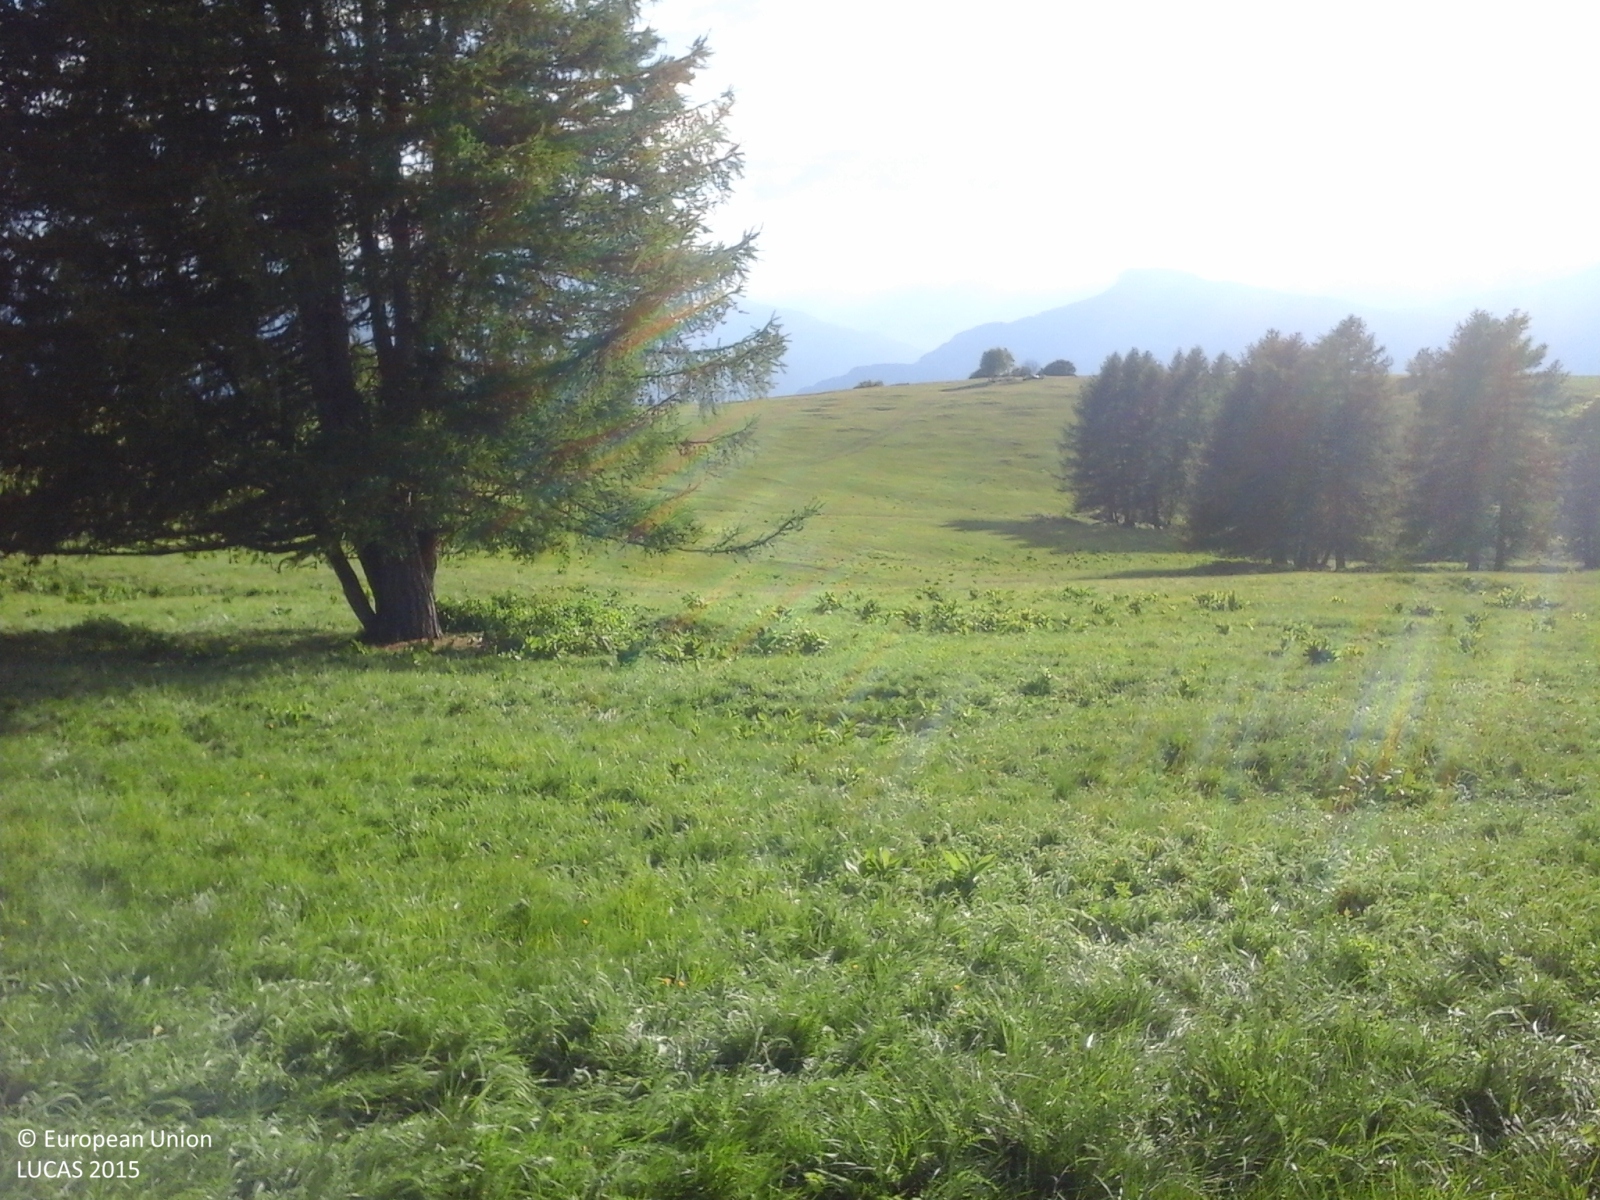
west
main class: Grassland
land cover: Grassland without tree/shrub cover
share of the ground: > 75 %
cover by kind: herbaceous plants 100 %
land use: Agriculture (excluding fallow land and kitchen gardens)
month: May
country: IT
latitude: 45.8949
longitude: 11.1196
